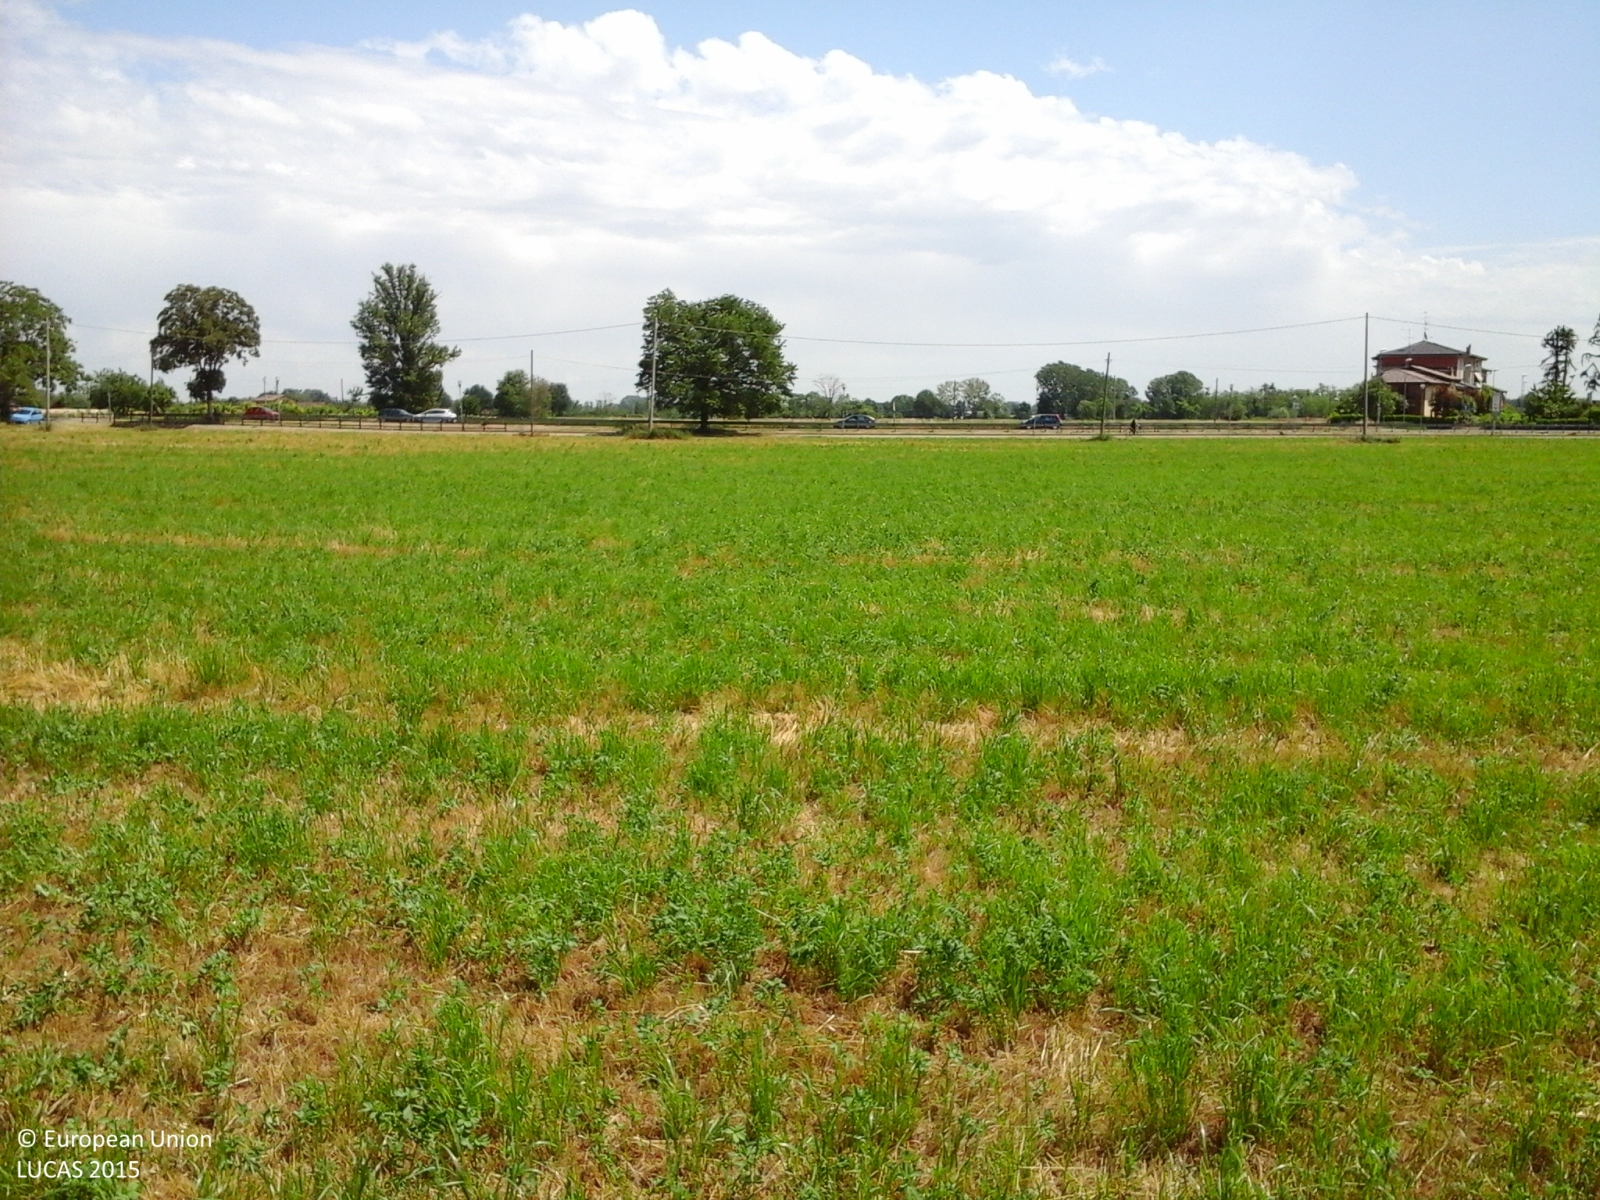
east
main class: Cropland
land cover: Lucerne
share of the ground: > 75 %
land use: Agriculture (excluding fallow land and kitchen gardens)
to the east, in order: Lucerne; Grass margins; Paved roads, cycling and walking lanes; Grass margins; Electric lines; Paved roads, cycling and walking lanes; Grass margins; Electric lines; Paved roads, cycling and walking lanes; Grass margins; Electric lines; Lucerne; Electric lines; Lucerne
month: May
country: IT
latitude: 44.6552
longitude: 10.6418
